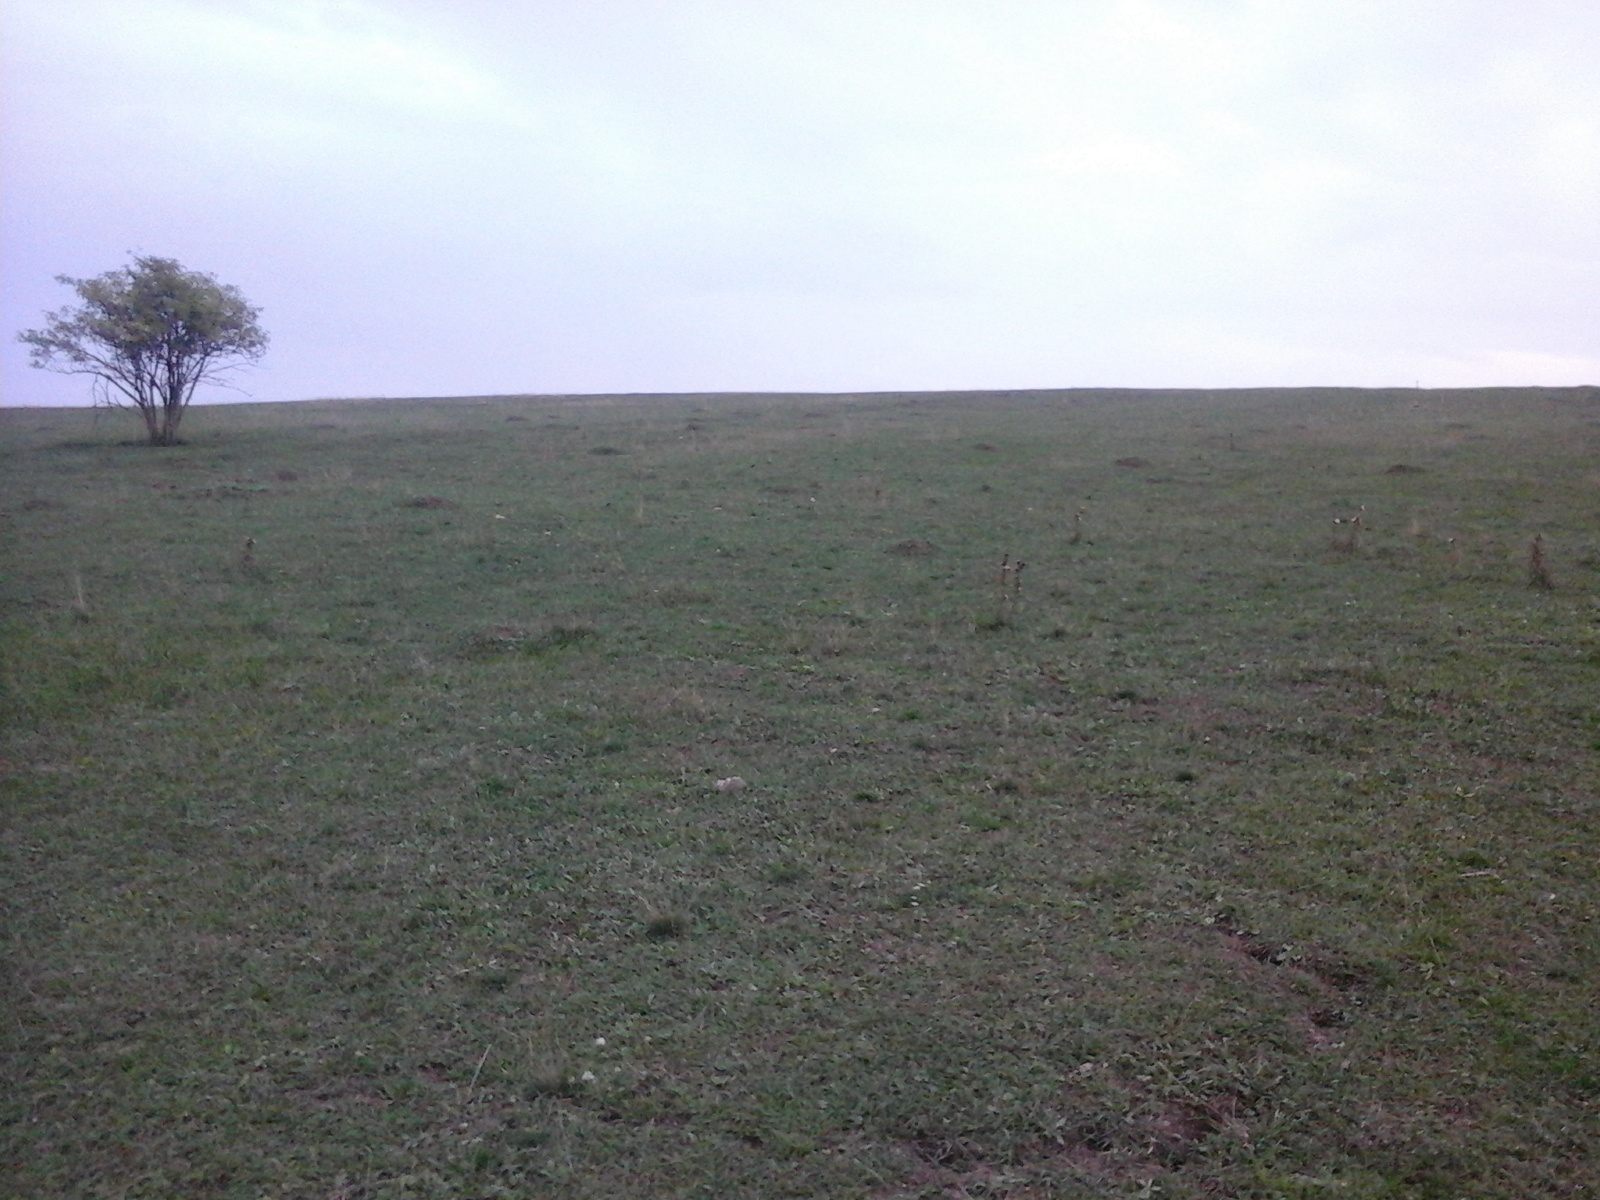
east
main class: Grassland
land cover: Grassland without tree/shrub cover
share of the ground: > 75 %
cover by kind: herbaceous plants 100 %
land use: Agriculture (excluding fallow land and kitchen gardens)
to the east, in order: Grassland without tree/shrub cover; Tracks; Grass margins; Maize
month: September
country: RO
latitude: 45.8315
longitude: 22.9666
